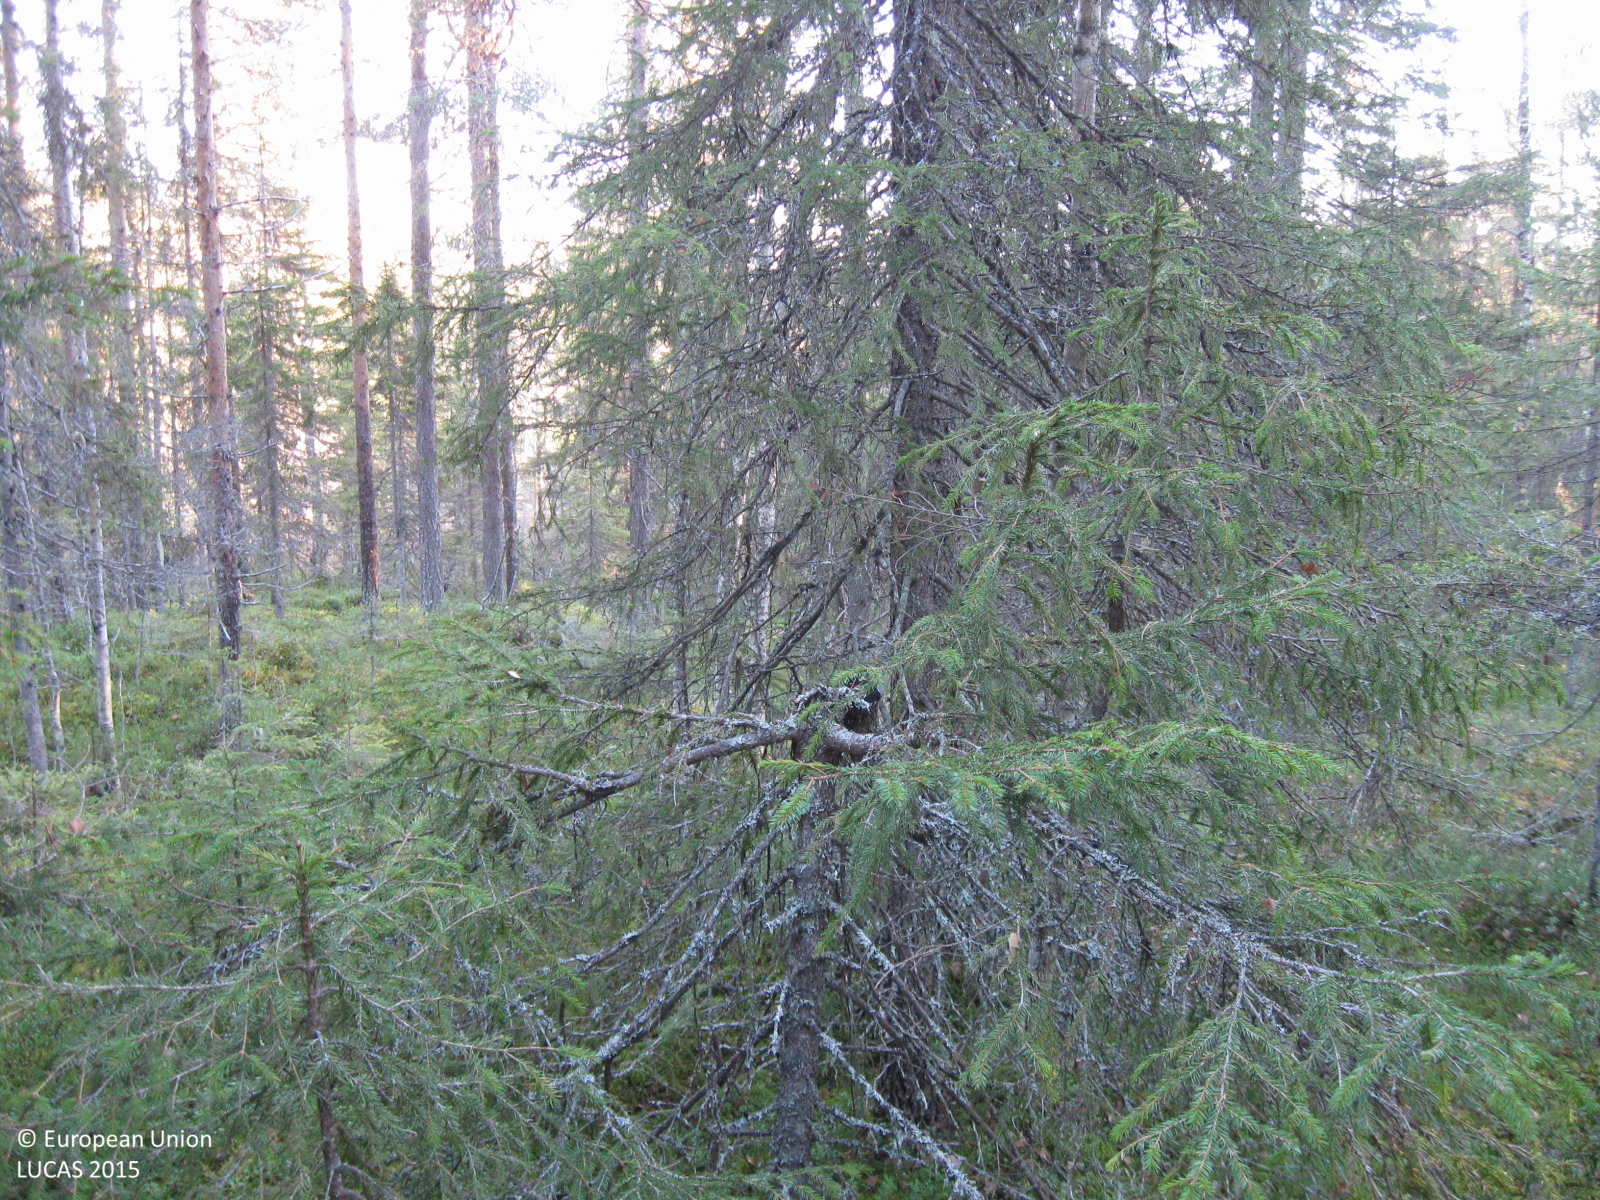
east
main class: Woodland
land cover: Other coniferous woodland
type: boreal forest
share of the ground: > 75 %
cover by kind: coniferous forest trees 80 %, broadleaved forest trees 5 %, shrubs 5 %, herbaceous plants 5 %, lichens and mosses 5 %
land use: Forestry
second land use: Amenities, museums, leisure
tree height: > 5 m
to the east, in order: Other coniferous woodland; Other mixed woodland; Other coniferous woodland; Tracks; Other coniferous woodland; Other mixed woodland; Other coniferous woodland
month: November
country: SE
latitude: 66.1340
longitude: 20.7485
